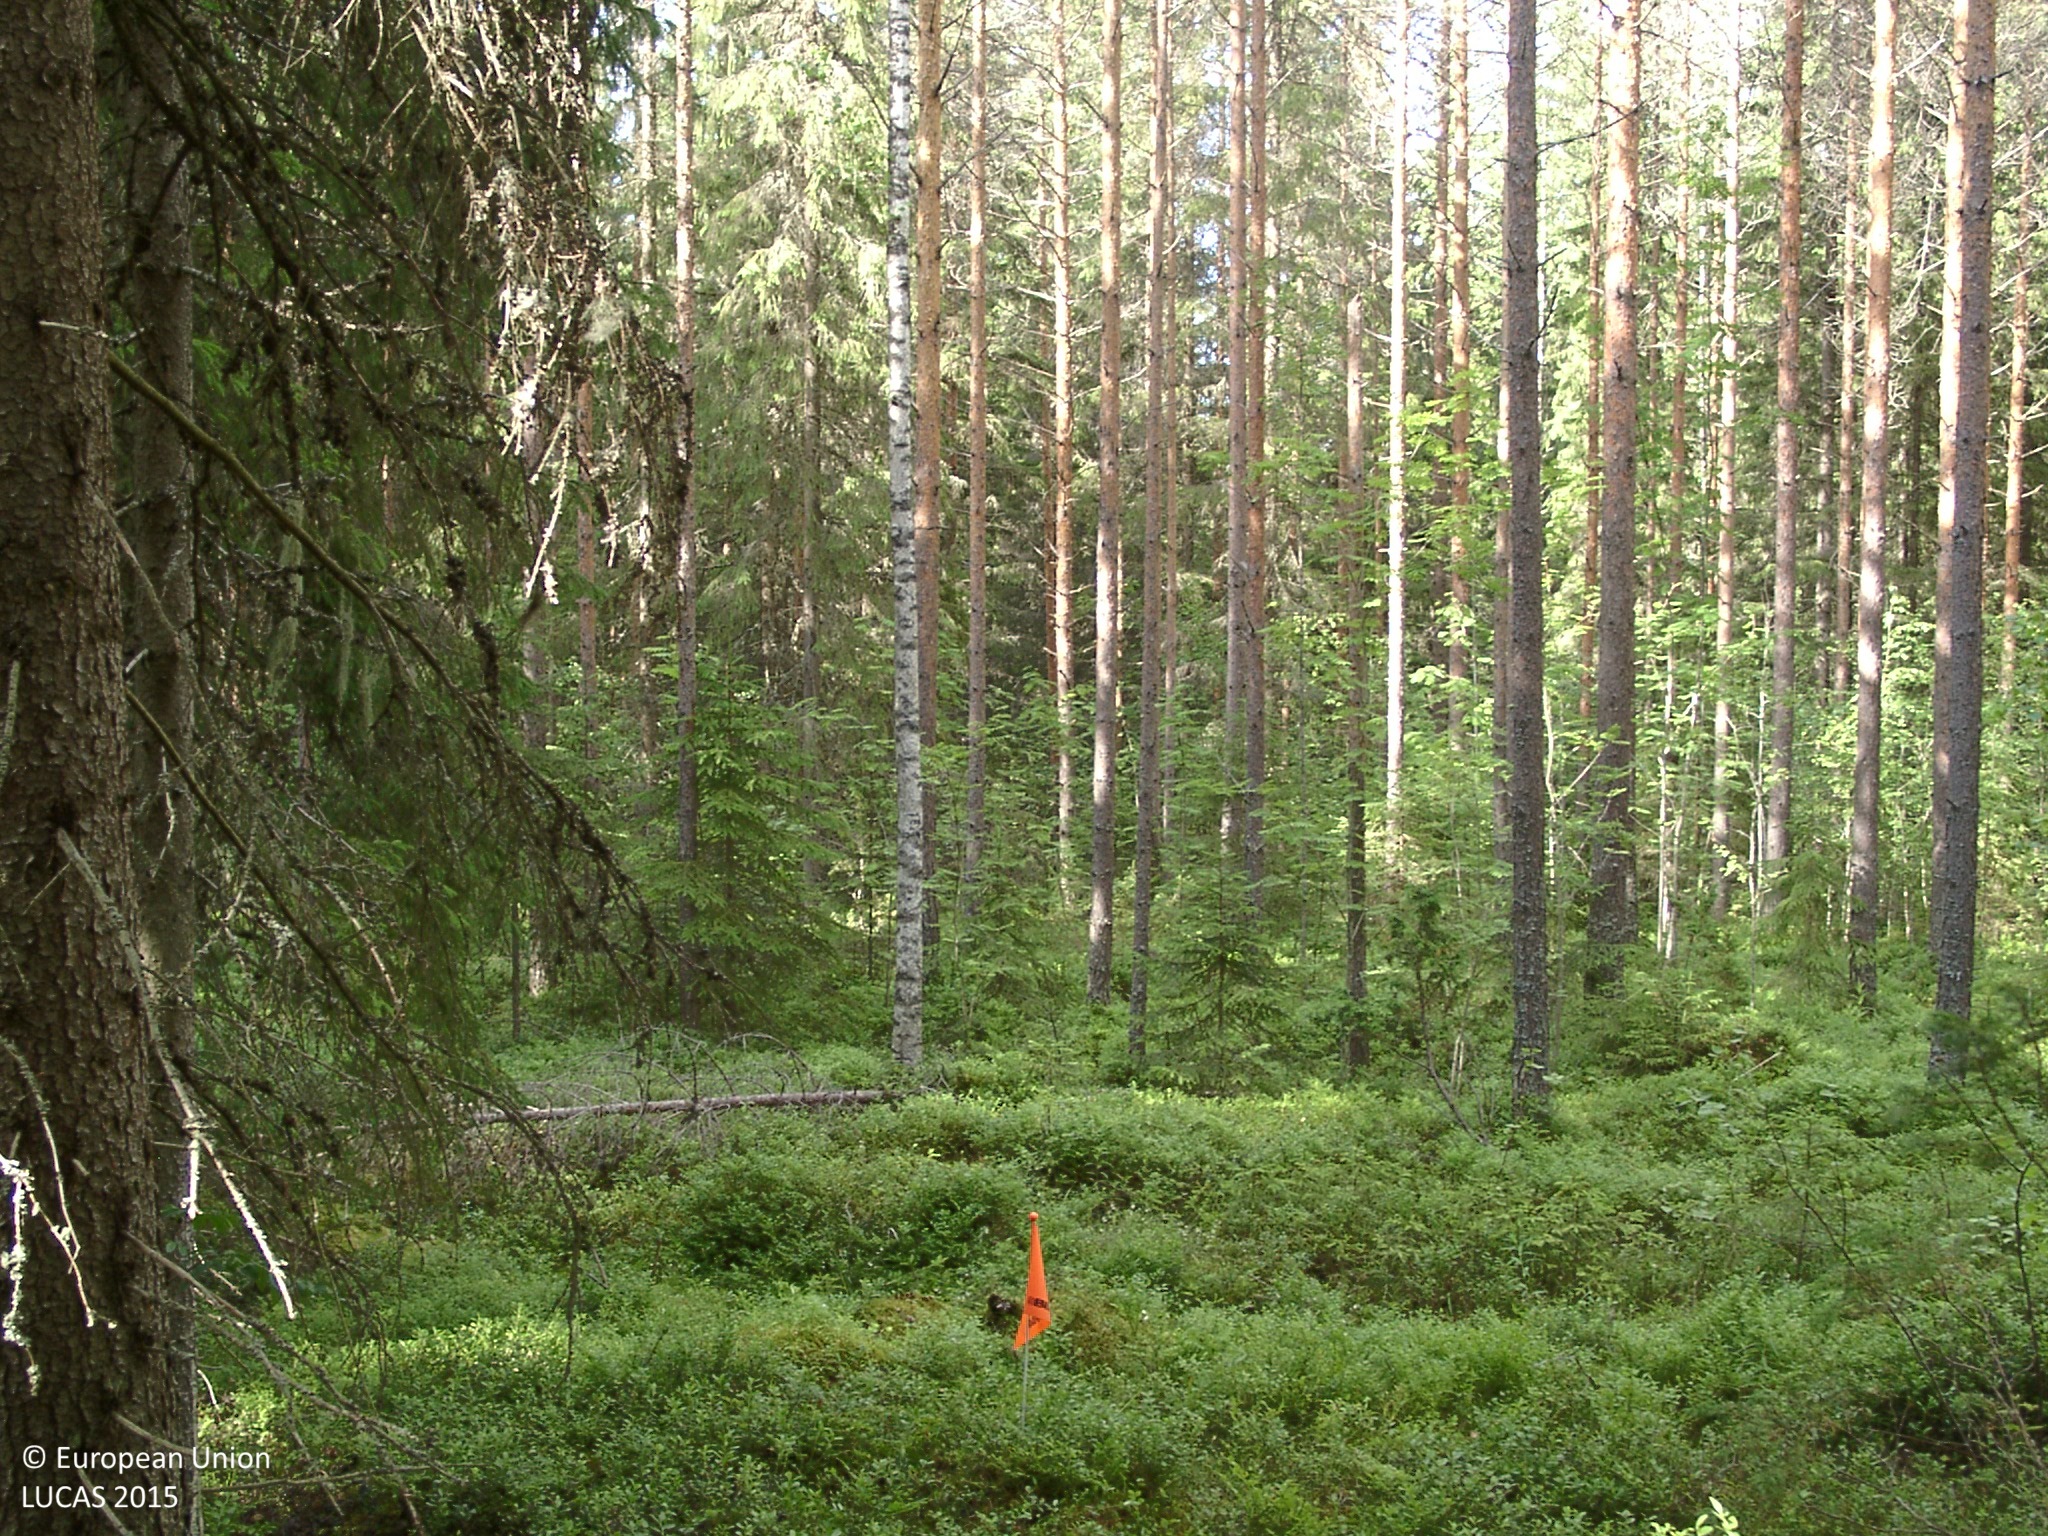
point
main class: Woodland
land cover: Other coniferous woodland
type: boreal forest
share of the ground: 50 - 75 %
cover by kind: coniferous forest trees 55 %, shrubs 25 %, broadleaved forest trees 15 %, lichens and mosses 5 %
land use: Forestry
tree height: > 5 m
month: July
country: FI
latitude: 62.2242
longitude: 25.1679
